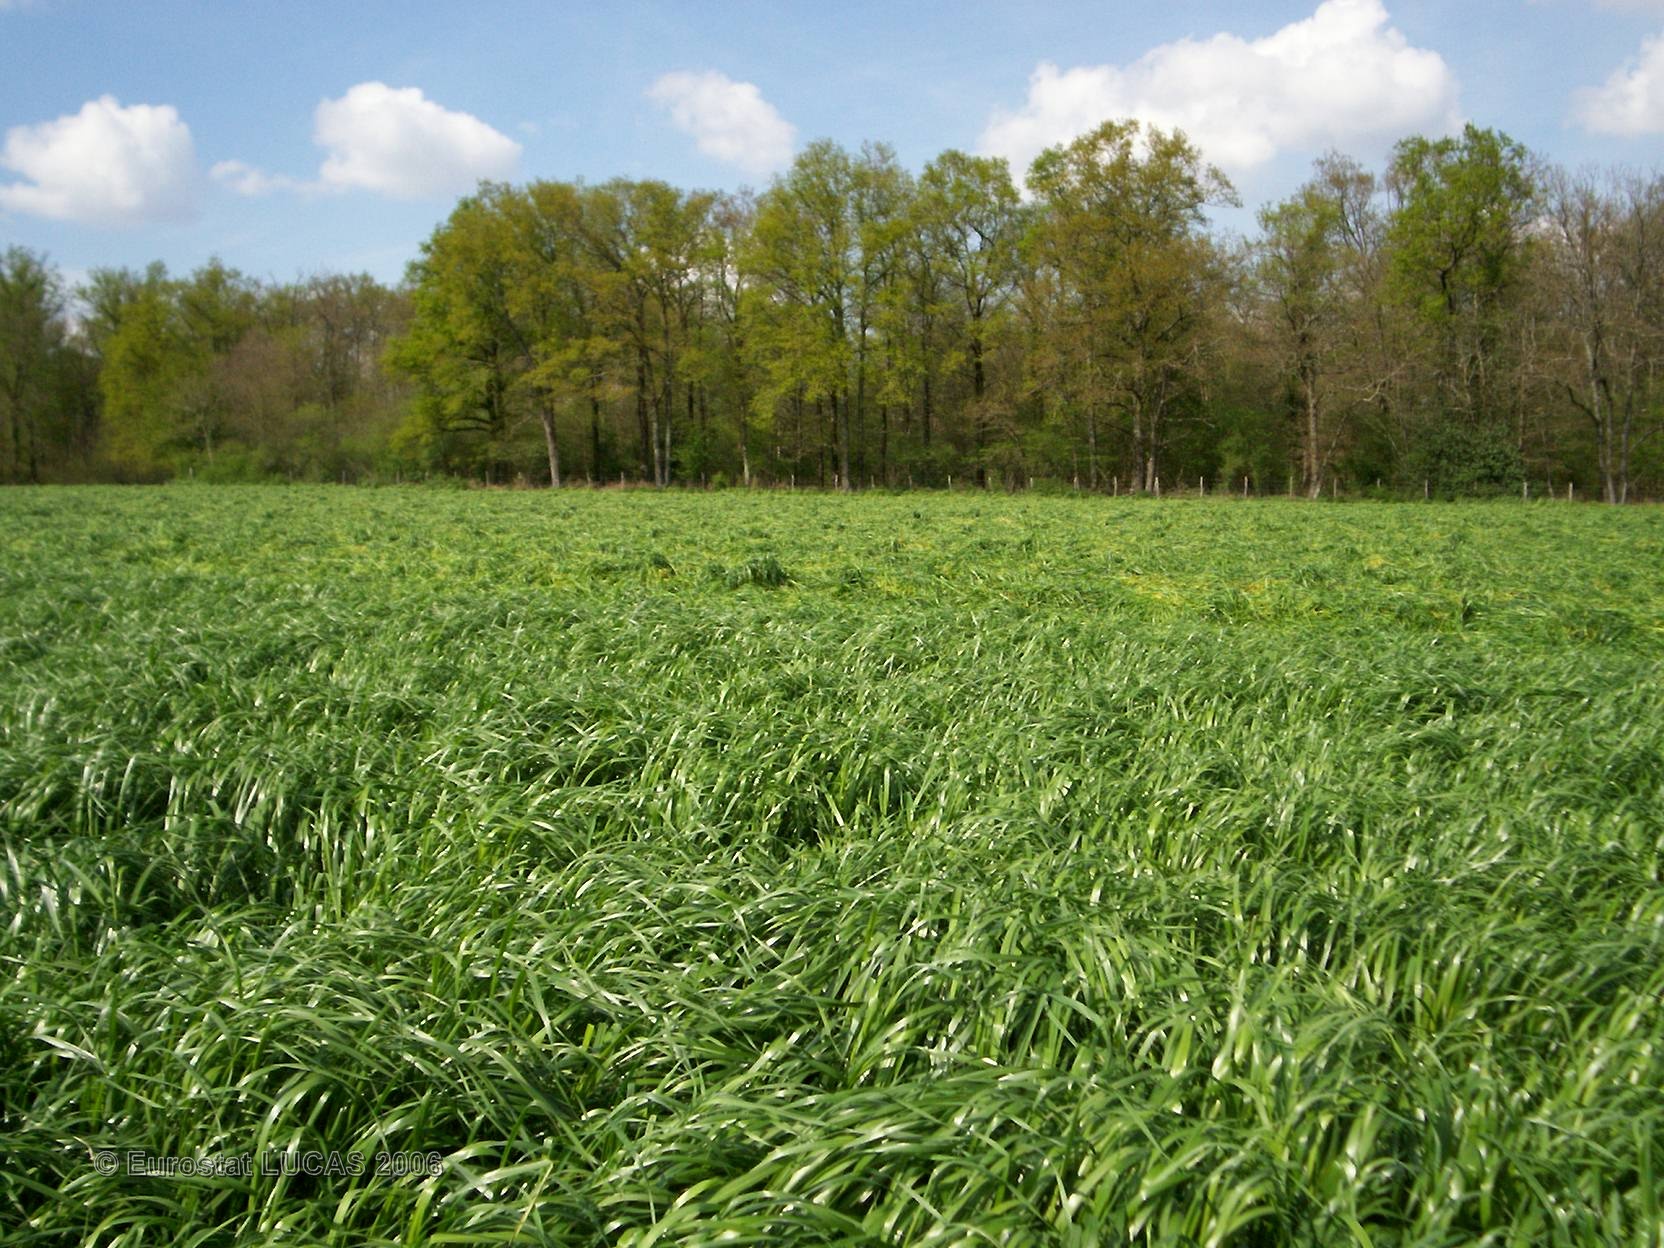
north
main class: Grassland
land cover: Grassland without tree/shrub cover
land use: Agriculture (excluding fallow land and kitchen gardens)
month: April
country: FR
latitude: 46.9256
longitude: 0.5120
